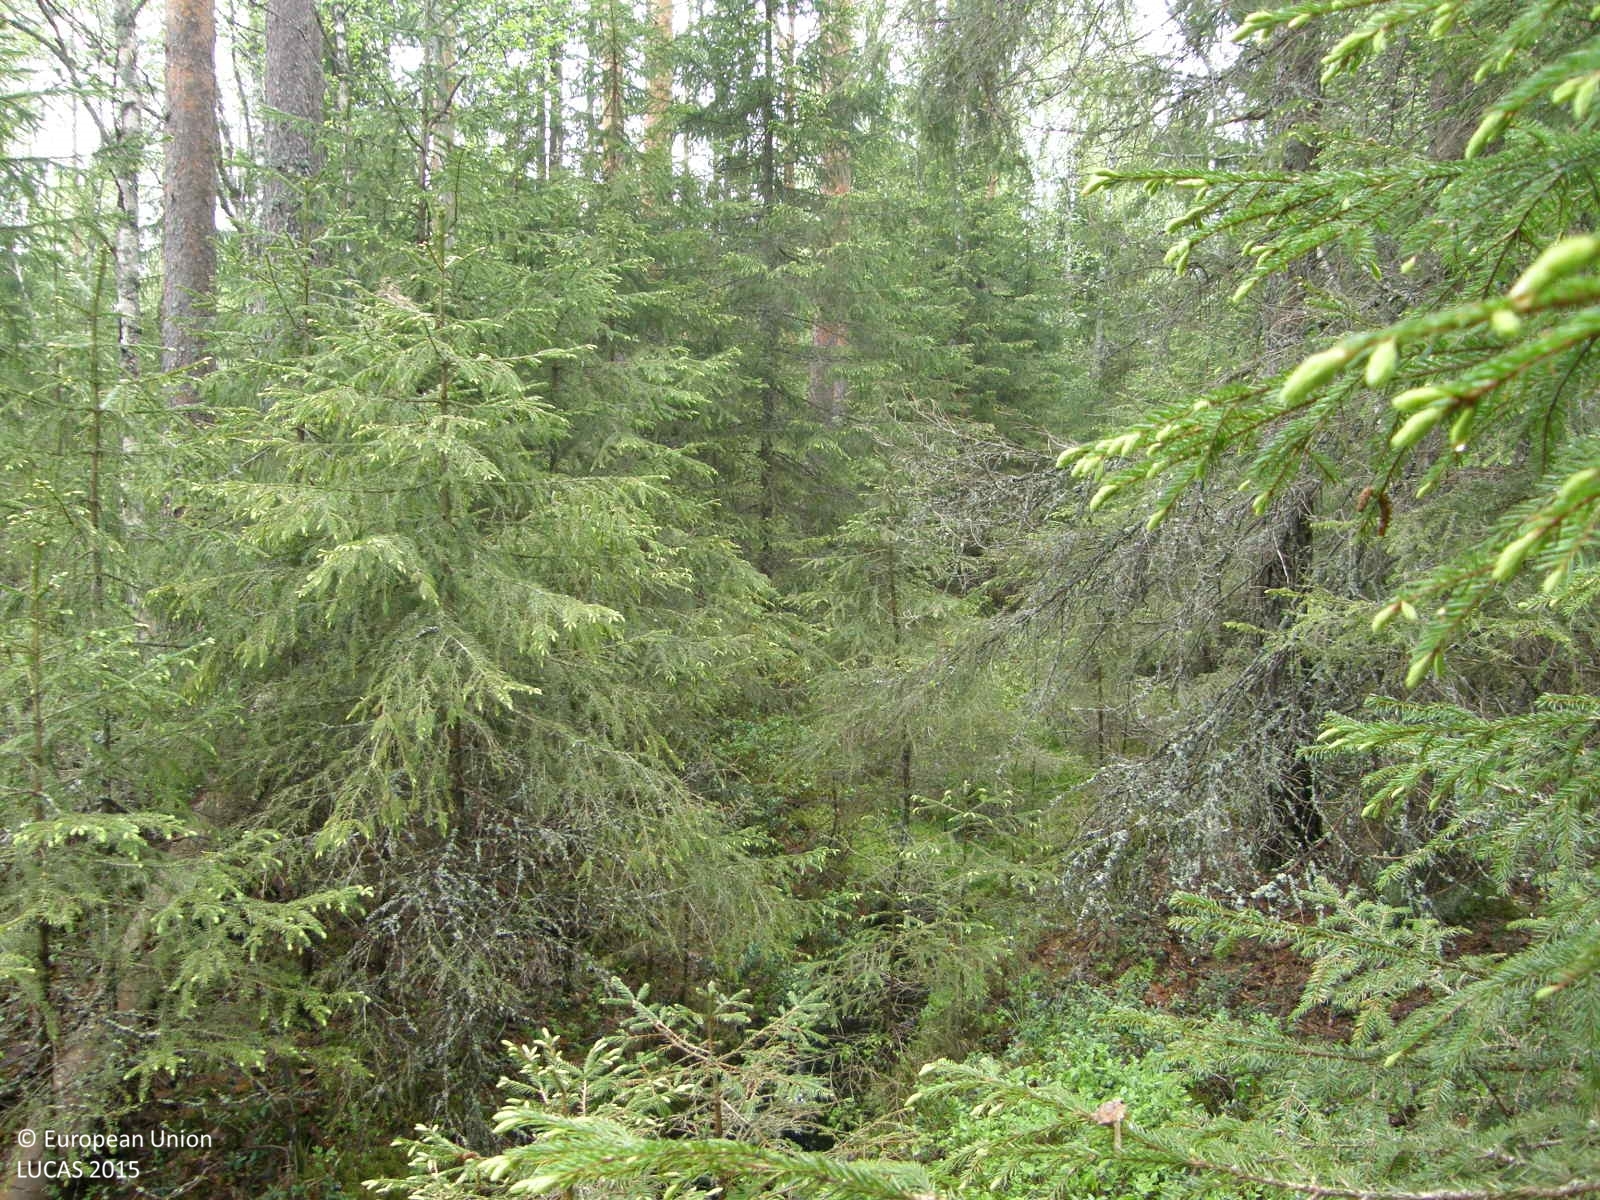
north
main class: Woodland
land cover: Other mixed woodland
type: boreal forest
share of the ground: > 75 %
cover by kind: coniferous forest trees 60 %, broadleaved forest trees 25 %, shrubs 15 %
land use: Forestry
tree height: > 5 m
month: June
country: FI
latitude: 62.0395
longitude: 21.7695
